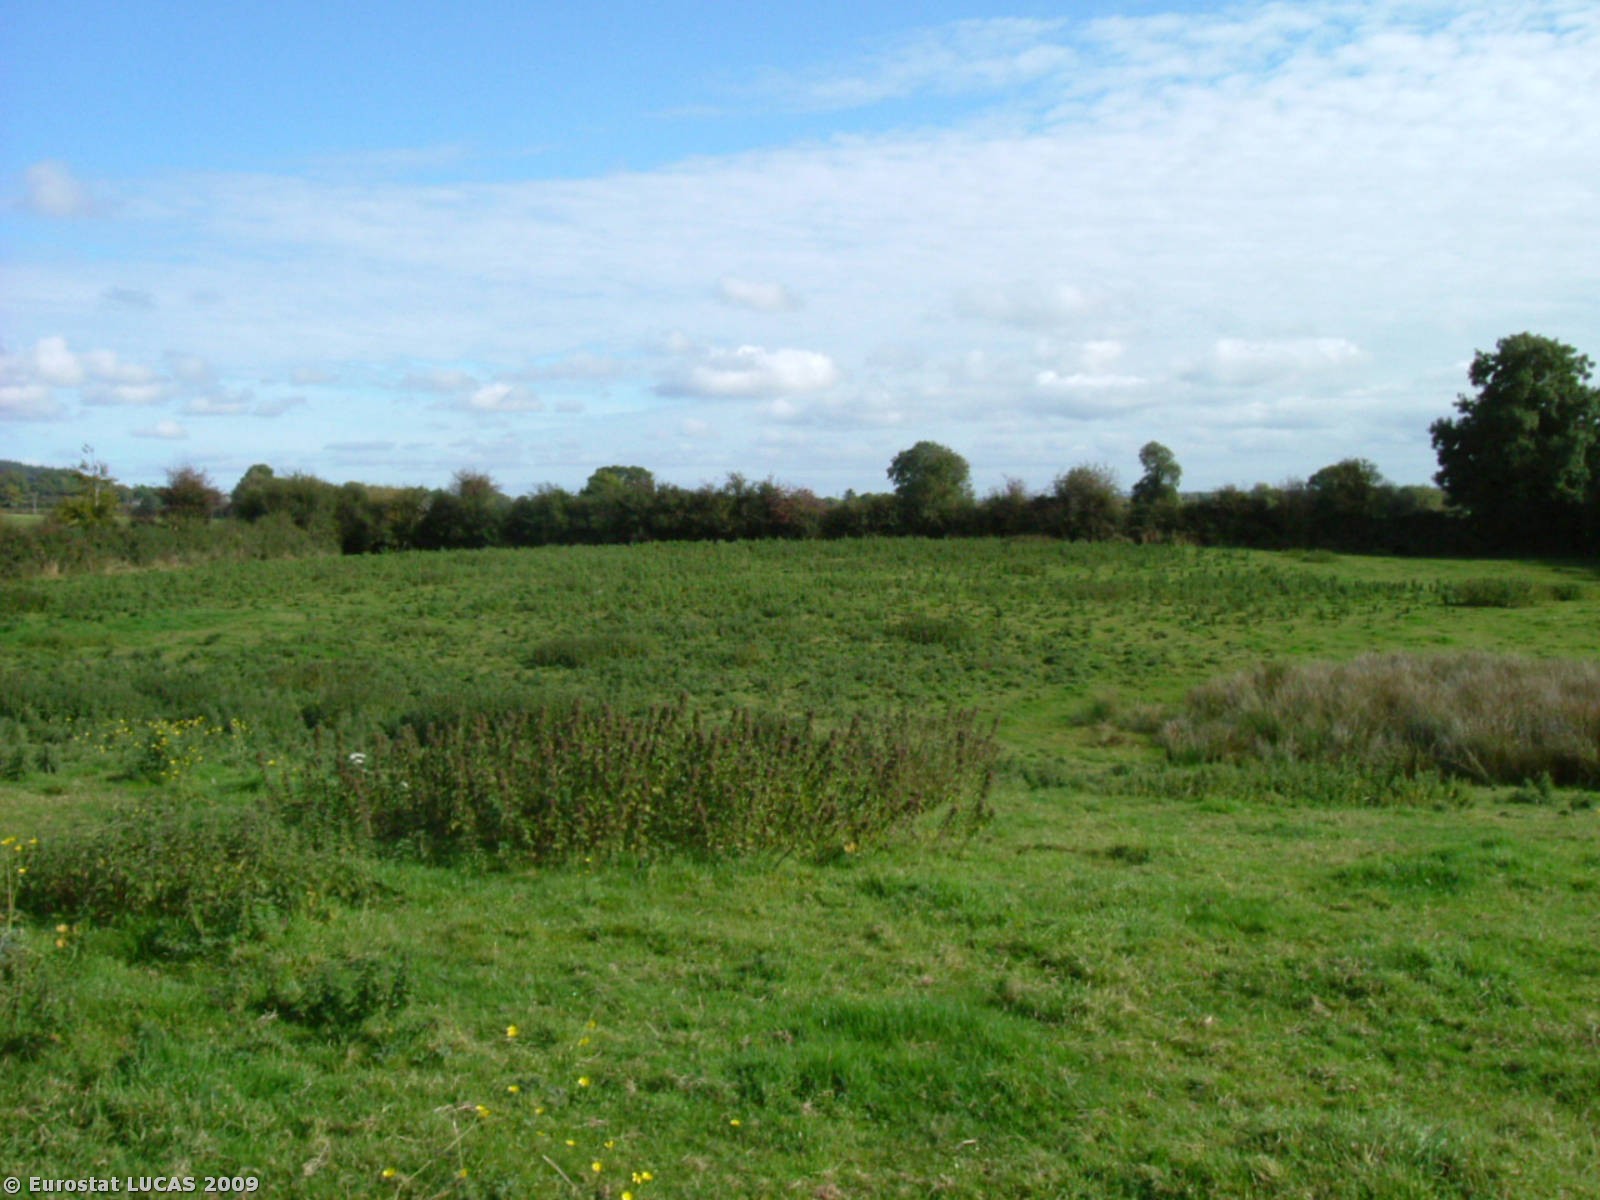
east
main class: Grassland
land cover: Grassland without tree/shrub cover
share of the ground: > 75 %
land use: Agriculture (excluding fallow land and kitchen gardens)
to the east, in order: Grassland without tree/shrub cover; Managed hedges; Grassland without tree/shrub cover
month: October
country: IE
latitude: 52.5558
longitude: -8.1002
